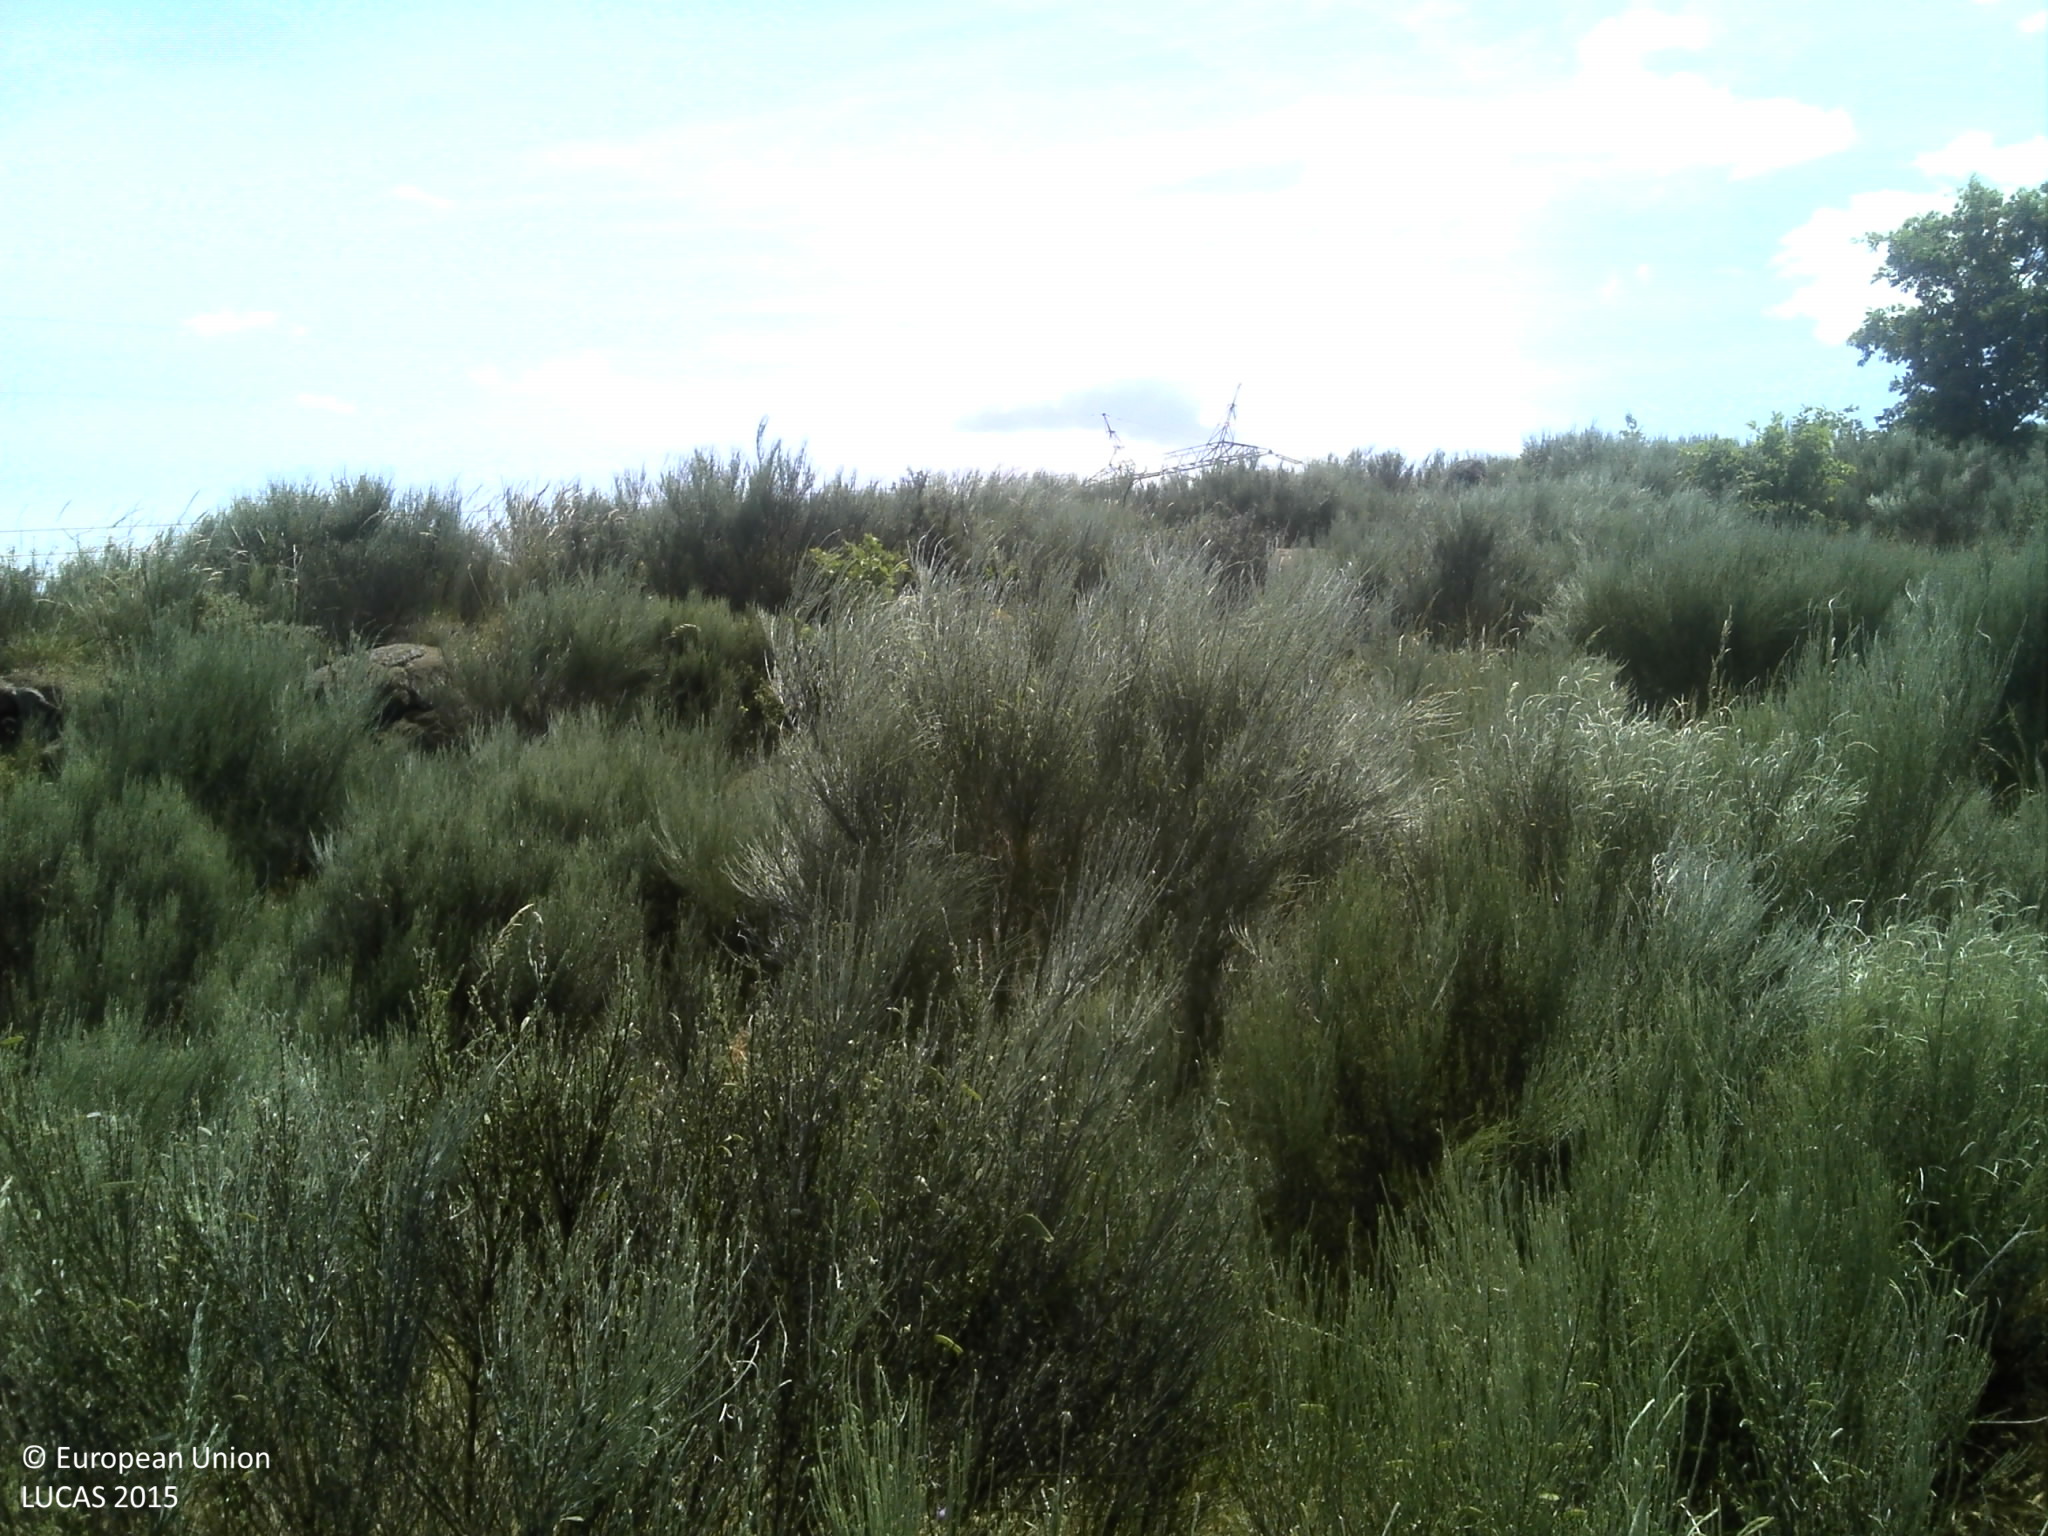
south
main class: Shrubland
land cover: Shrubland without tree cover
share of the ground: 50 - 75 %
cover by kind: shrubs 75 %, herbaceous plants 20 %, unconsolidated bare surface 5 %
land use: Semi-natural and natural areas not in use
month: May
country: PT
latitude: 40.6090
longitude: -7.4499
